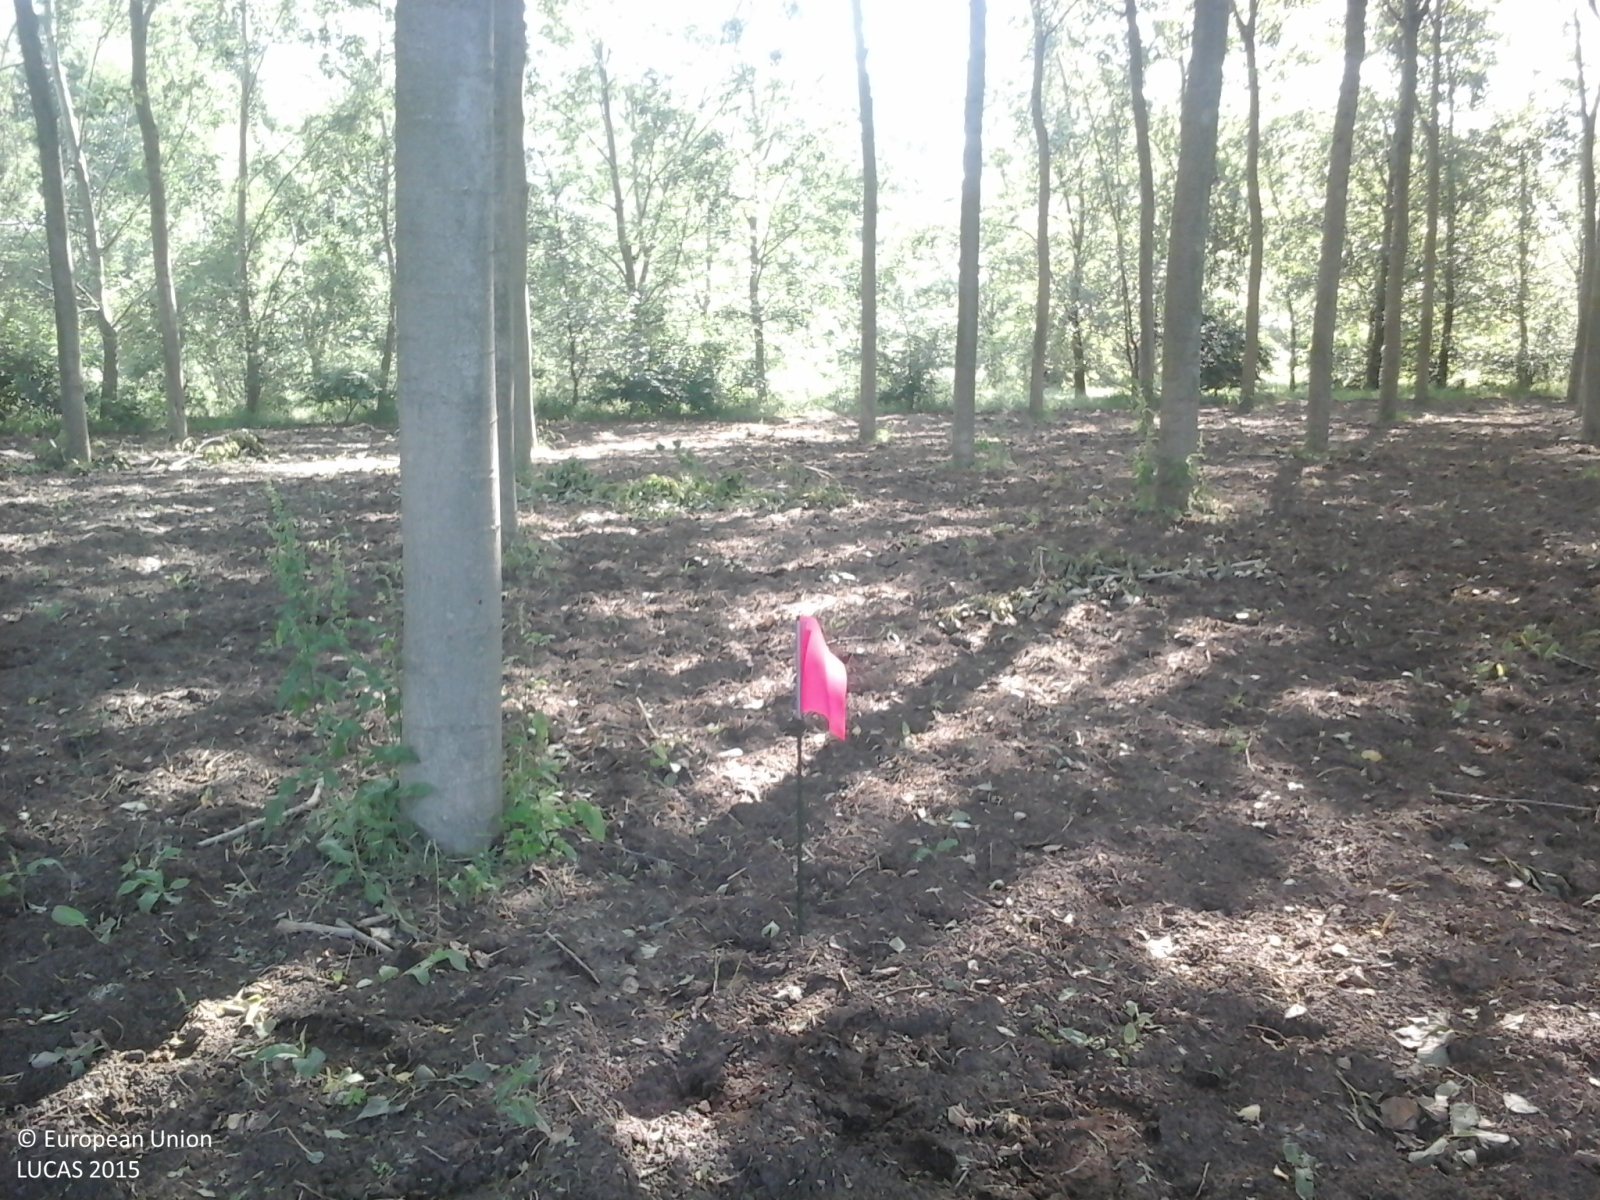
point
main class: Woodland
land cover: Broadleaved woodland
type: non-riverine alder, birch or aspen forest
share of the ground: > 75 %
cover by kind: broadleaved forest trees 100 %
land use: Forestry
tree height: > 5 m
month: May
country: IT
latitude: 45.1063
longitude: 10.5708
